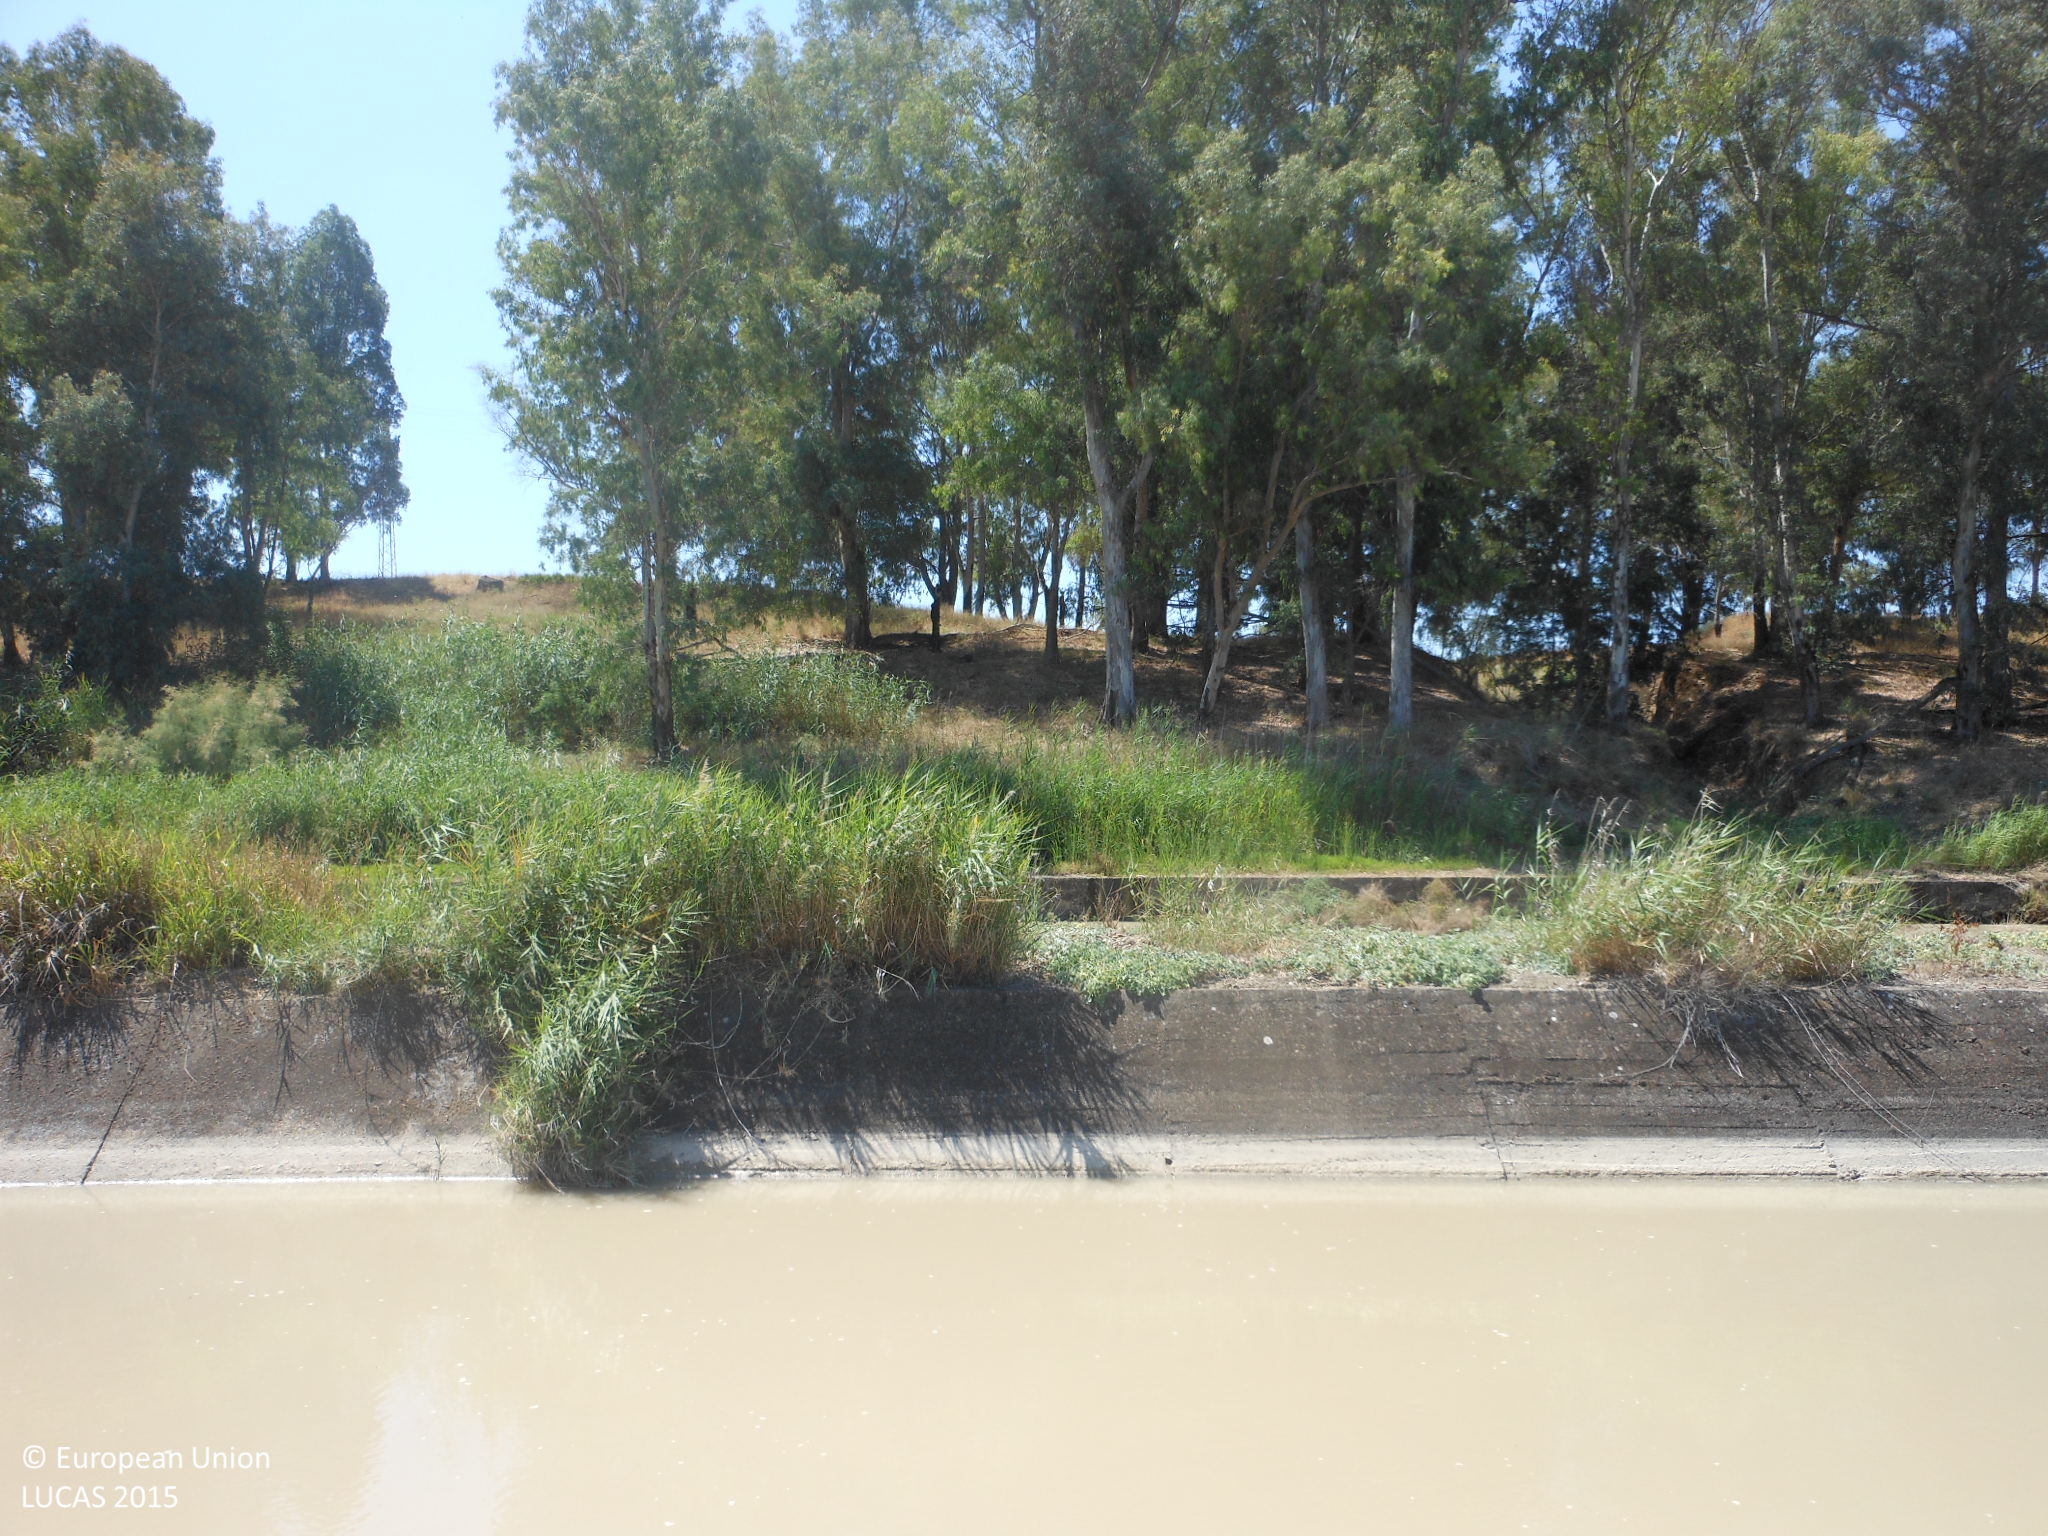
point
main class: Woodland
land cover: Broadleaved woodland
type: exotic forest
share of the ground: 50 - 75 %
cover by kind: broadleaved forest trees 55 %, herbaceous plants 30 %, consolidated bare surface 15 %
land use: Semi-natural and natural areas not in use
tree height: > 5 m
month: June
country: ES
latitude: 37.5874
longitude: -5.6385
